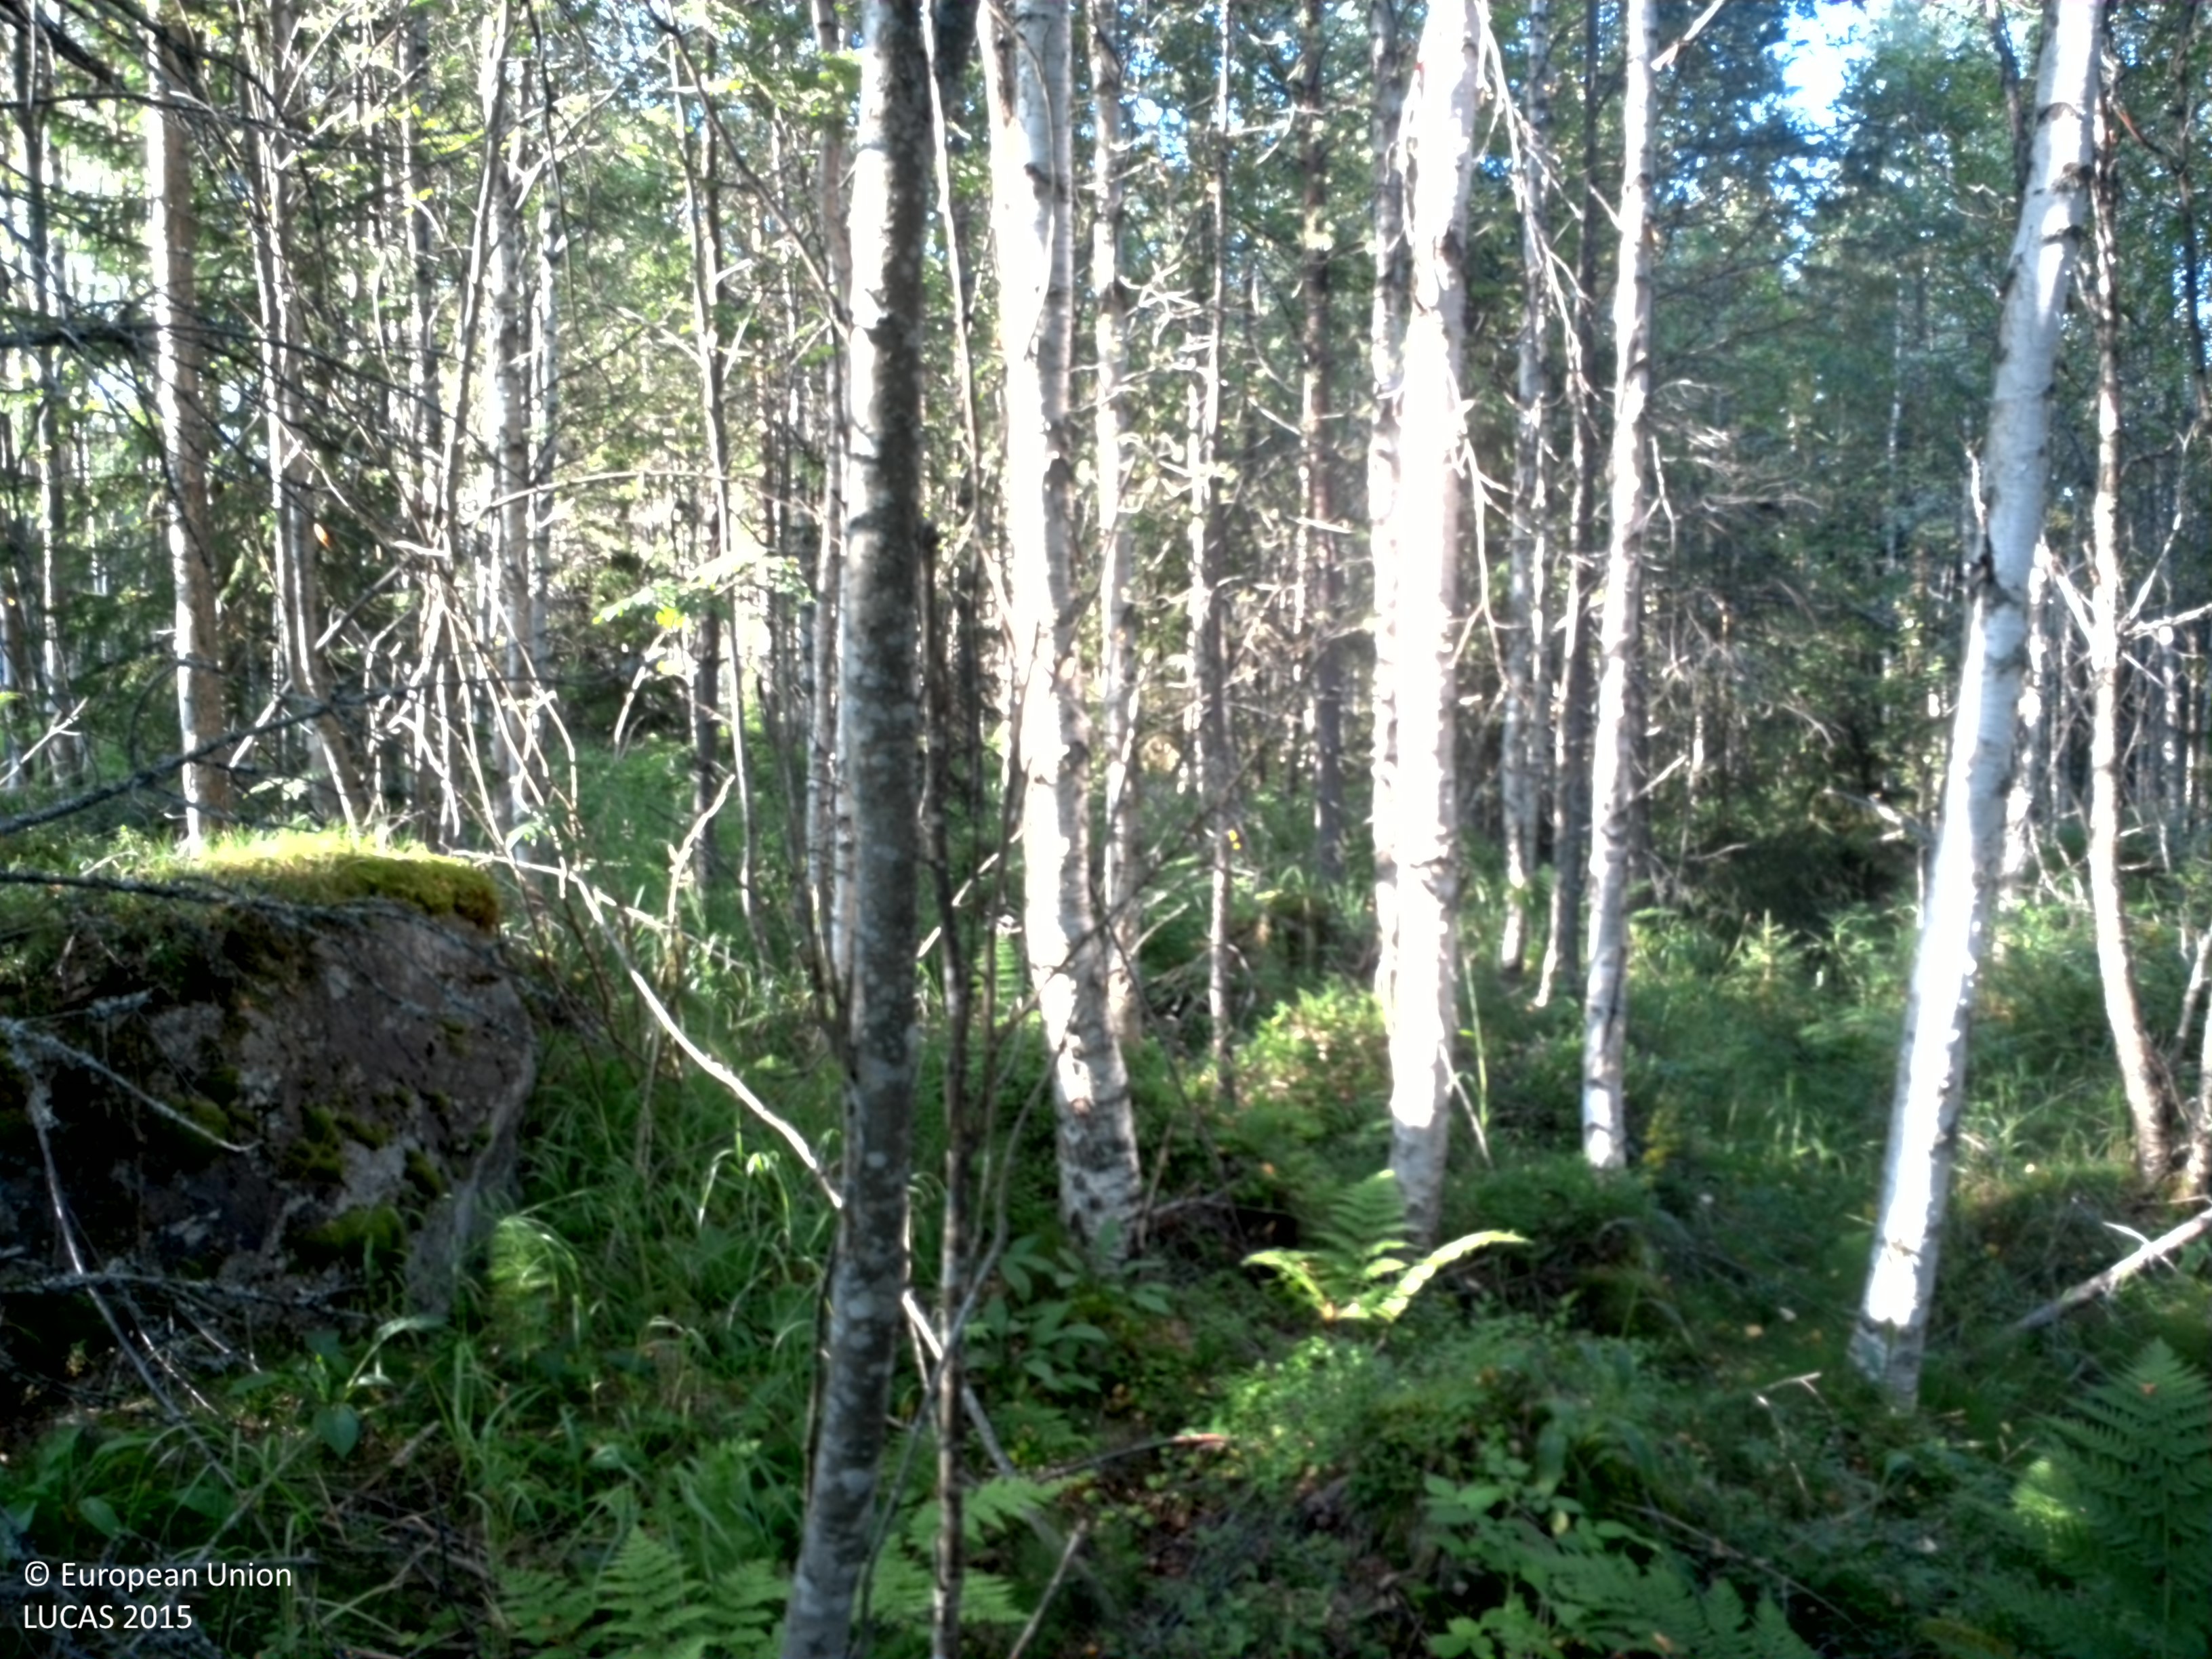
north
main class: Woodland
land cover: Pine dominated mixed woodland
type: boreal forest
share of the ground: > 75 %
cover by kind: coniferous forest trees 50 %, broadleaved forest trees 25 %, shrubs 15 %, herbaceous plants 10 %
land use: Forestry
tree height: > 5 m
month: August
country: SE
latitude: 61.8717
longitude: 15.2115
